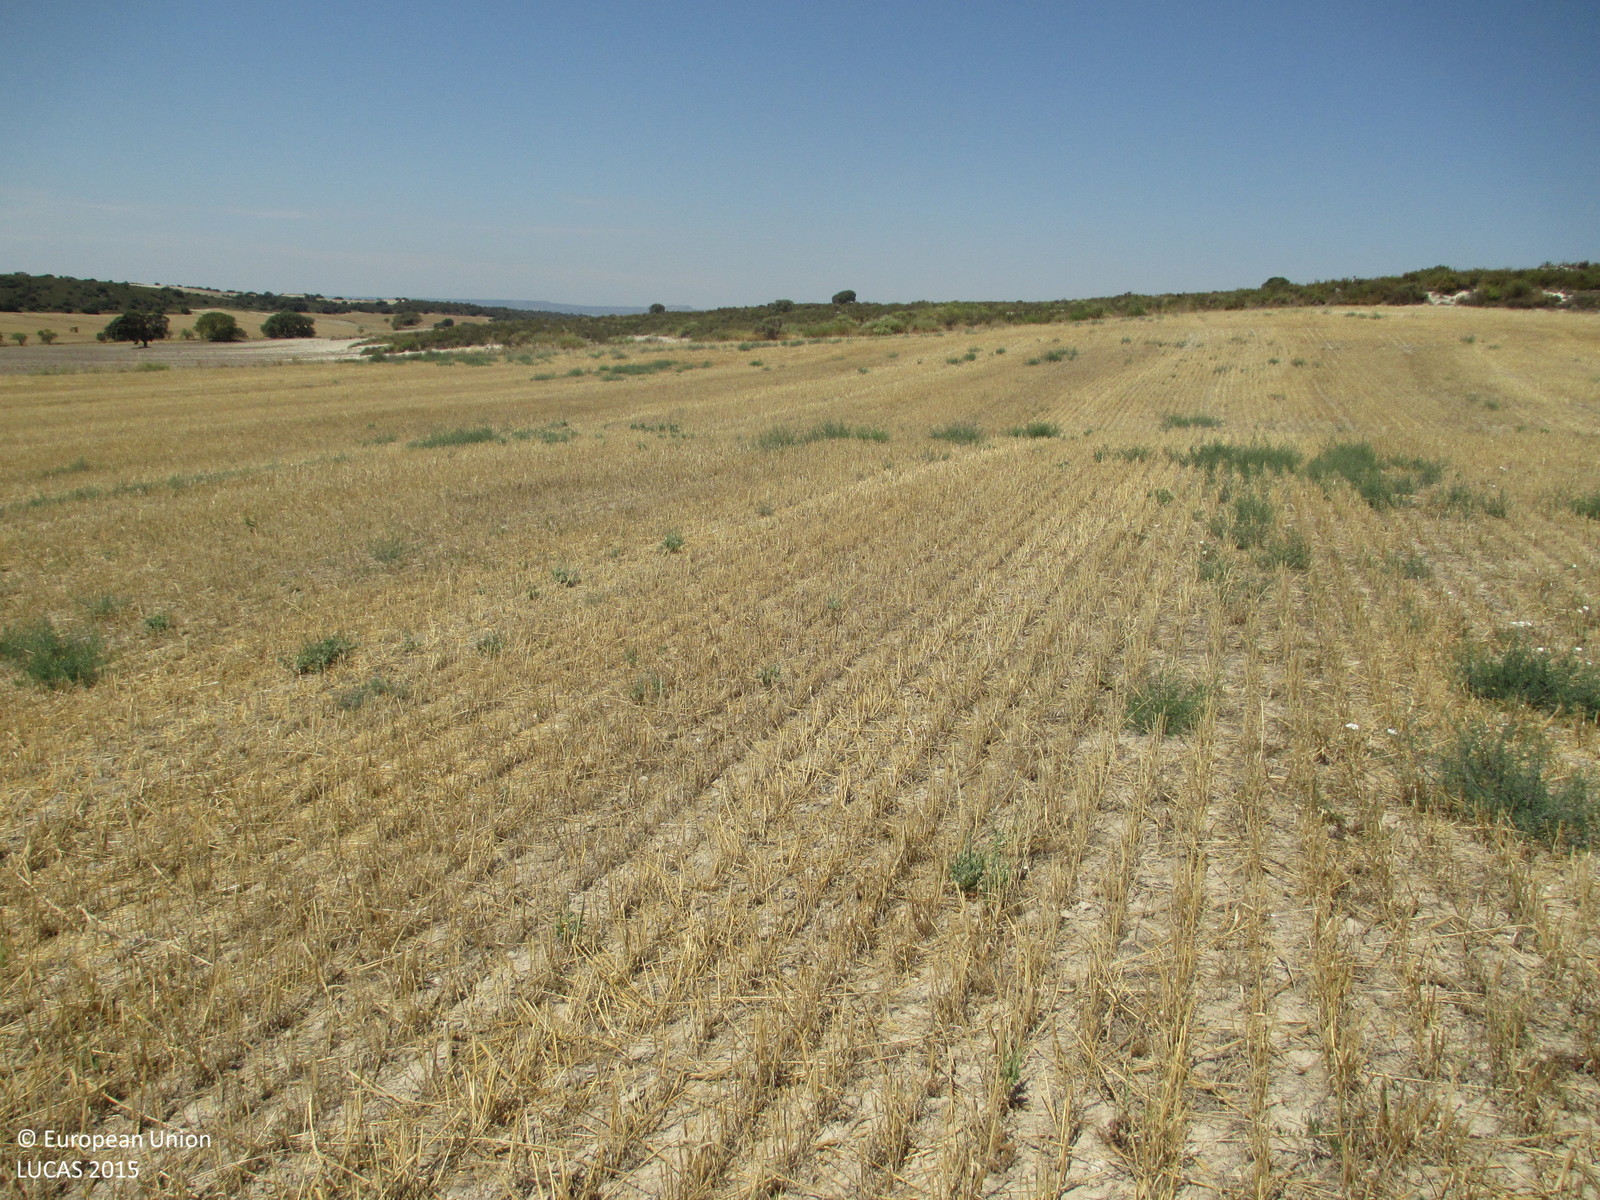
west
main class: Cropland
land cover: Barley
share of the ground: < 10 %
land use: Agriculture (excluding fallow land and kitchen gardens)
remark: Harvested field
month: July
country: ES
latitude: 41.9866
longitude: 0.2907
